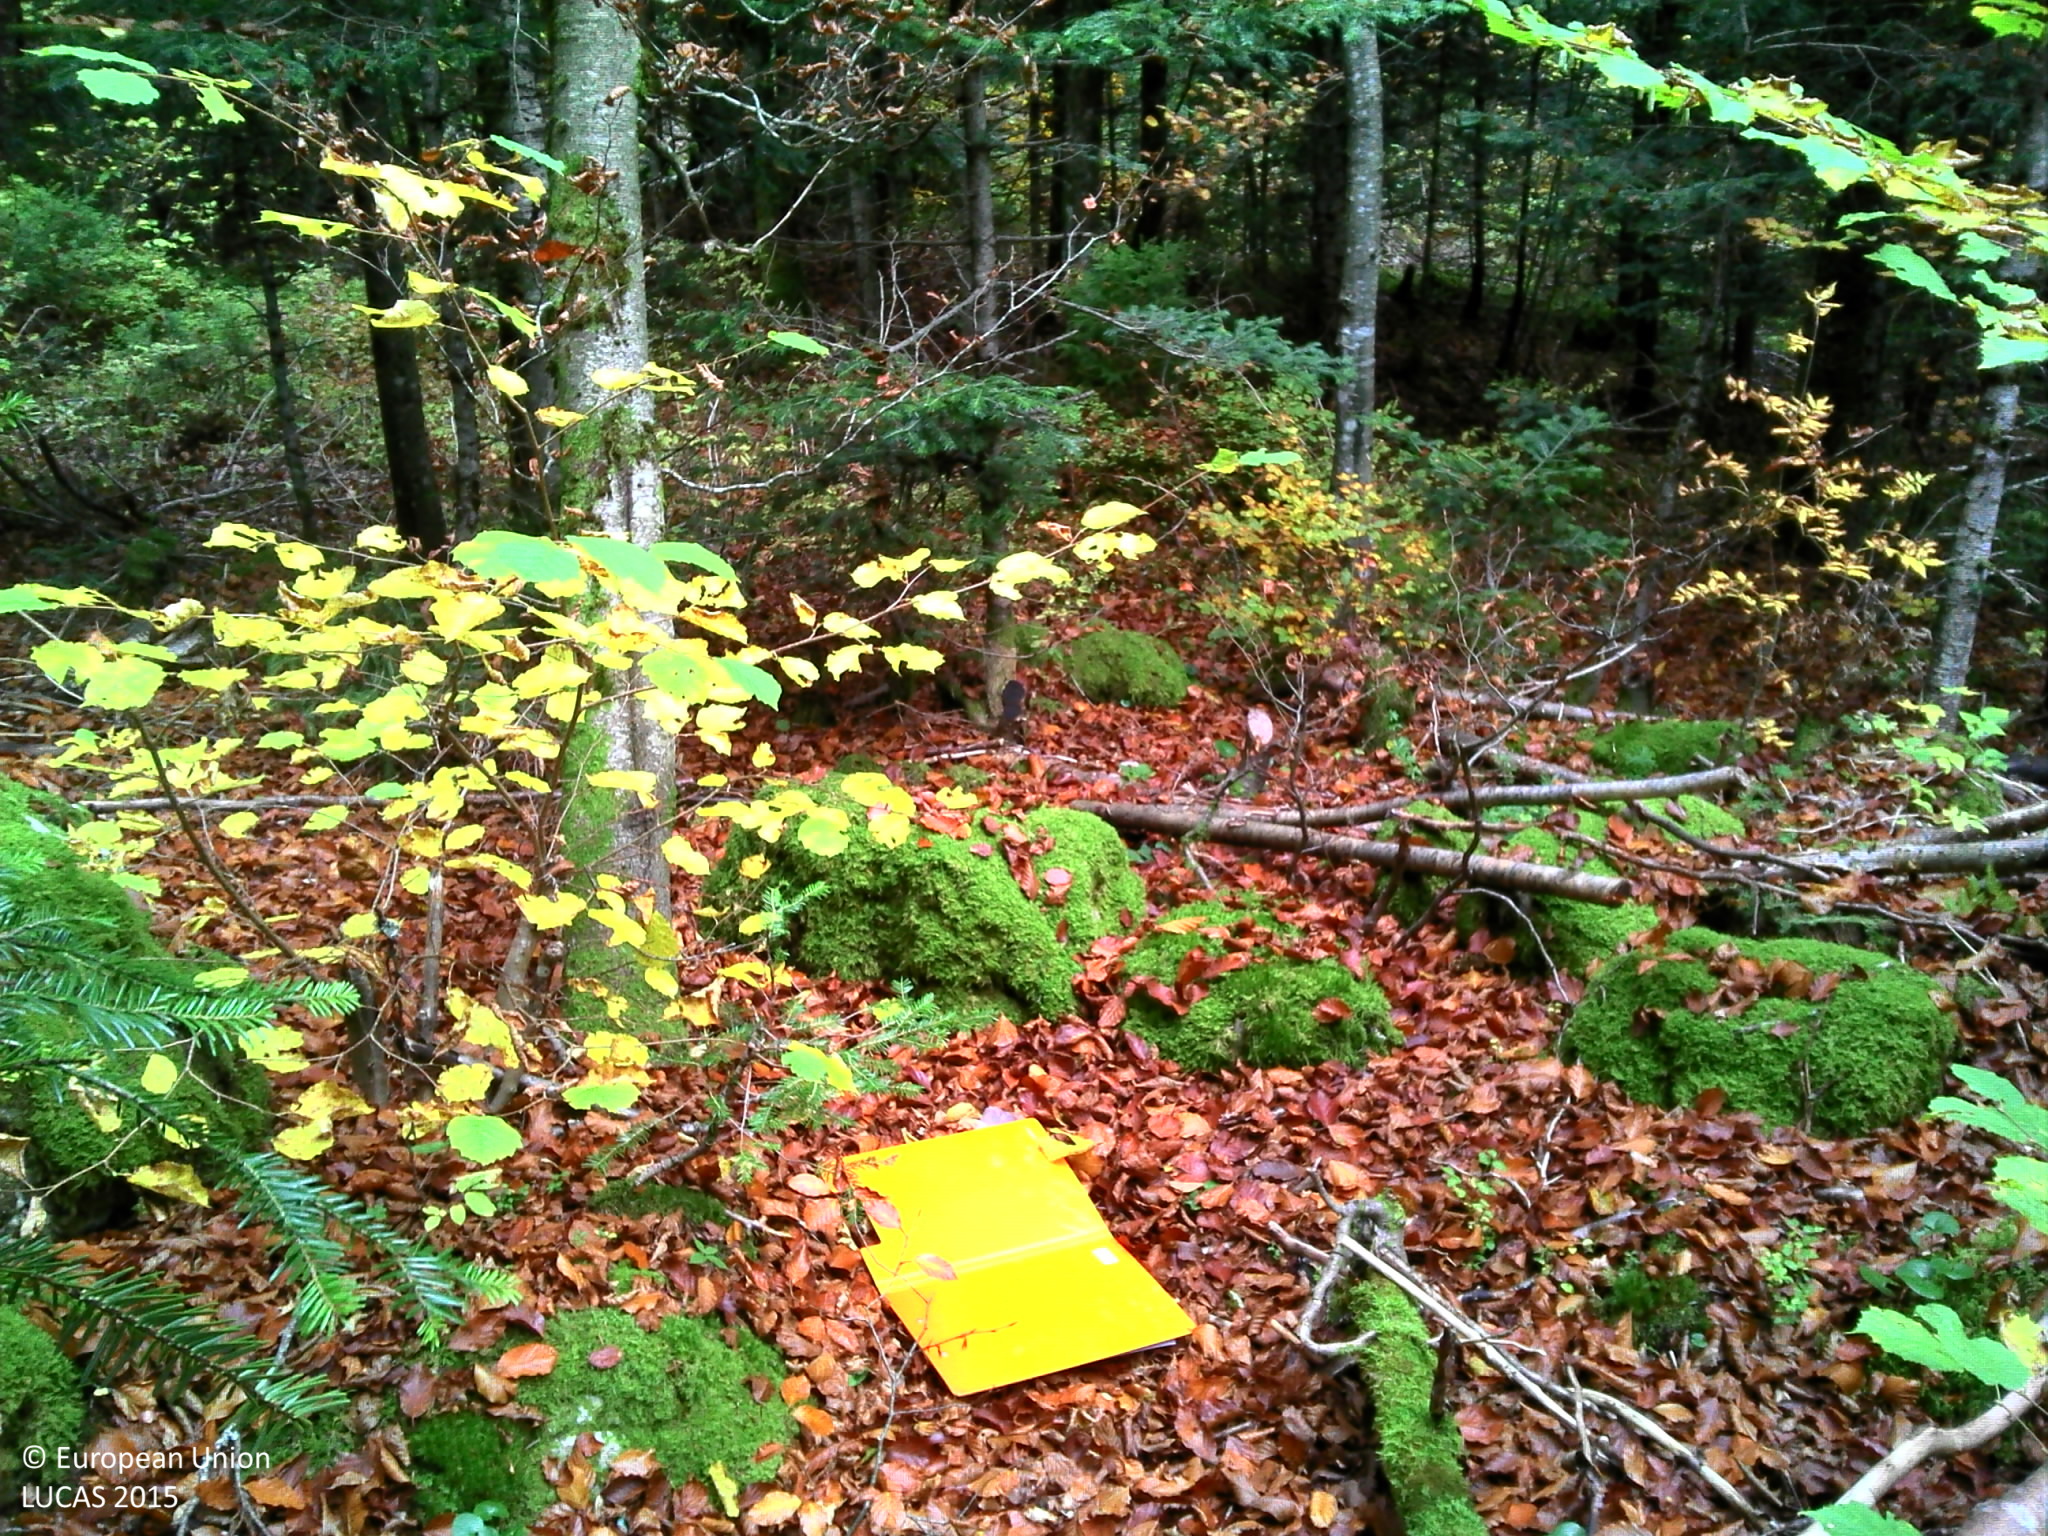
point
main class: Woodland
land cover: Spruce dominated mixed woodland
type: mountainous beech forest
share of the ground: > 75 %
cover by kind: coniferous forest trees 40 %, broadleaved forest trees 40 %, unconsolidated bare surface 10 %, lichens and mosses 5 %, consolidated bare surface 5 %
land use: Forestry
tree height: > 5 m
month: October
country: FR
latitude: 46.6964
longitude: 6.1448
